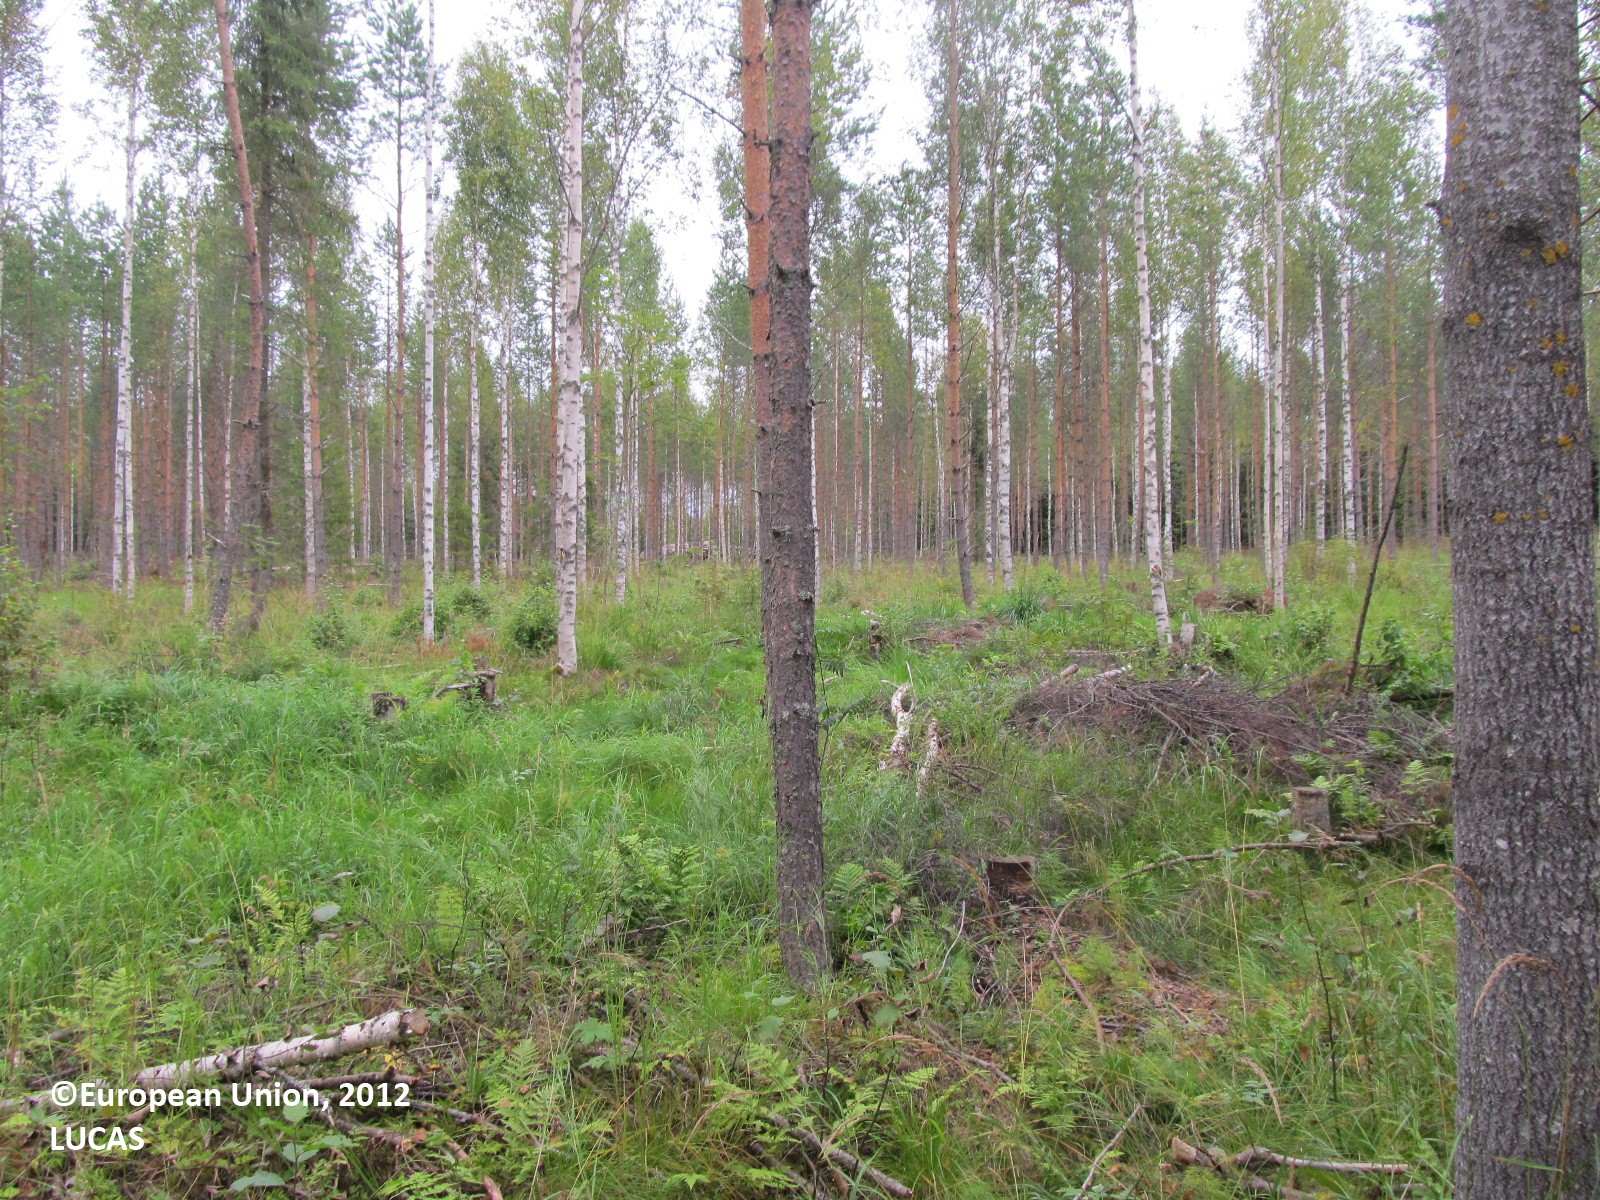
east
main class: Woodland
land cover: Pine dominated mixed woodland
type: boreal forest
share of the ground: 25 - 50 %
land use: Forestry
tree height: > 5 m
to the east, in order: Pine dominated mixed woodland; Spruce dominated coniferous woodland; Artificial constructions in urban areas; Spruce dominated coniferous woodland
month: August
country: FI
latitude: 63.1486
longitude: 27.8529
